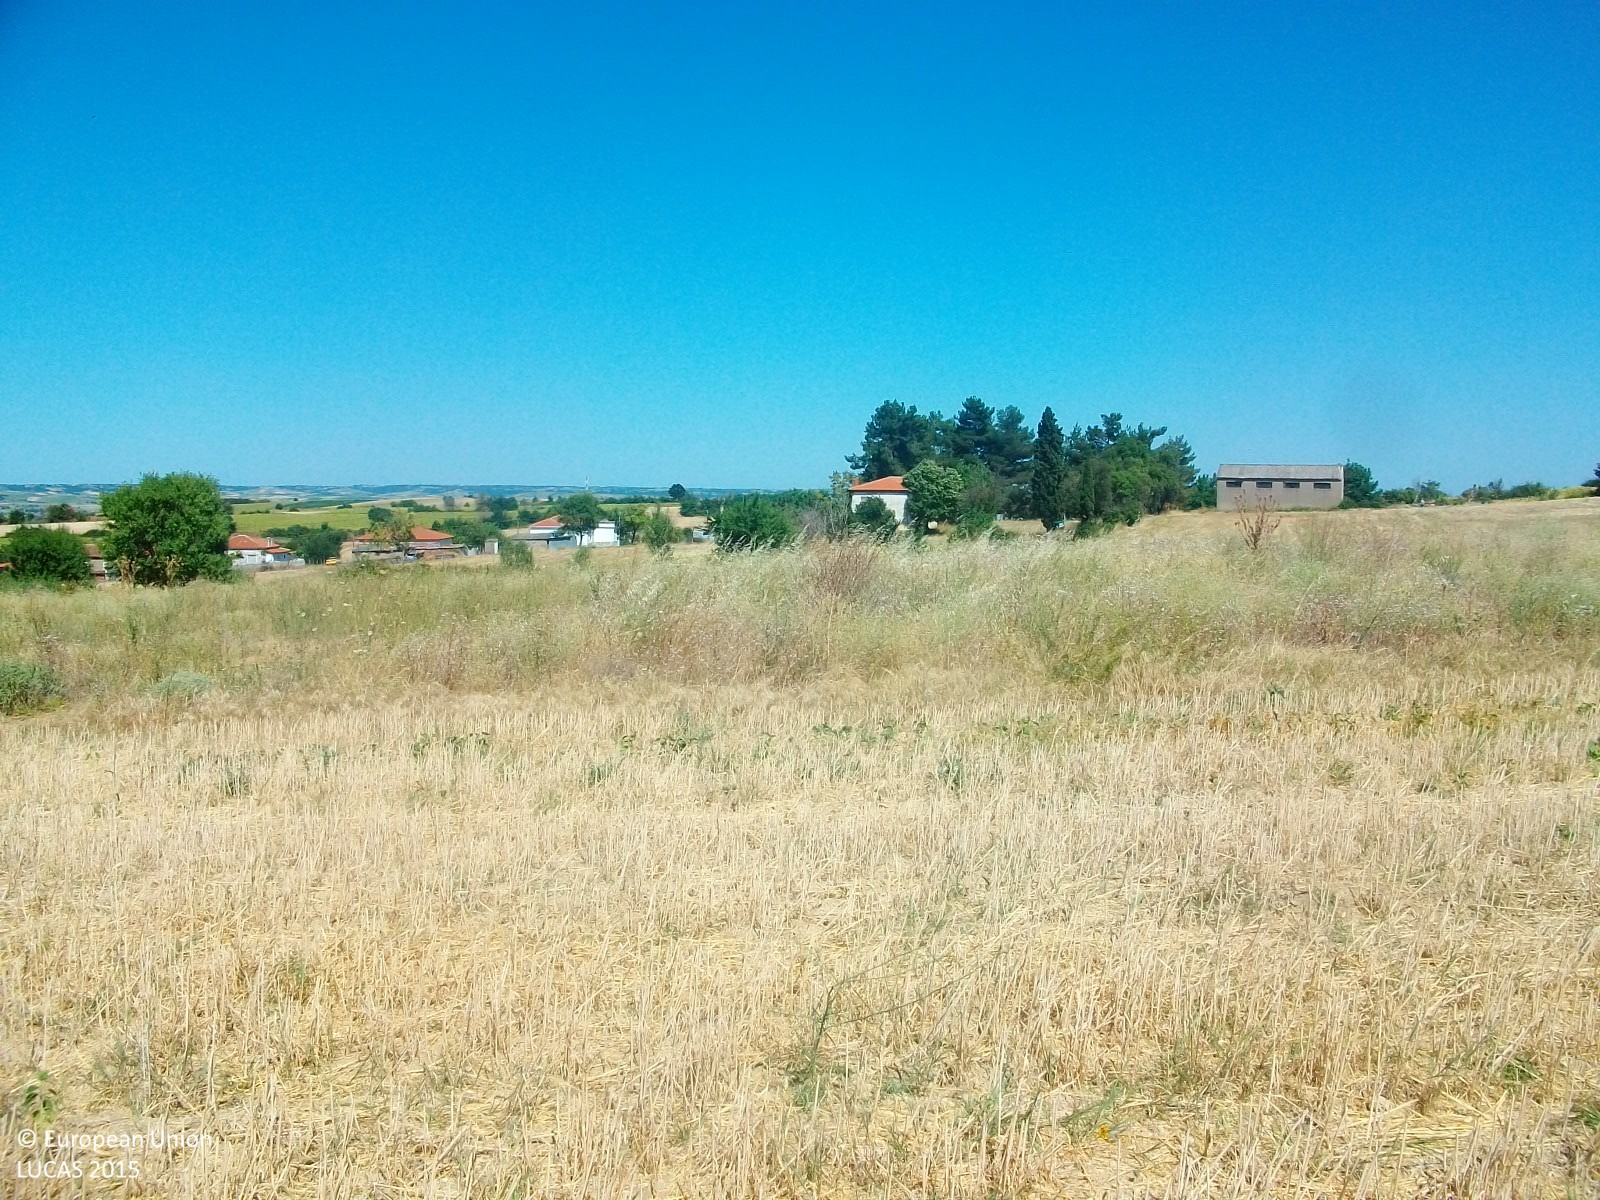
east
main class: Cropland
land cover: Common wheat
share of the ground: > 75 %
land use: Agriculture (excluding fallow land and kitchen gardens)
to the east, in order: Common wheat; Spontaneously vegetated surfaces; Common wheat; Shrubland without tree cover; Sunflower; Shrubland without tree cover; Artificial constructions in urban areas; Pine dominated coniferous woodland; Artificial constructions; Electric lines; Grass margins; Paved roads, cycling and walking lanes
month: July
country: GR
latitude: 41.4001
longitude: 26.2797
